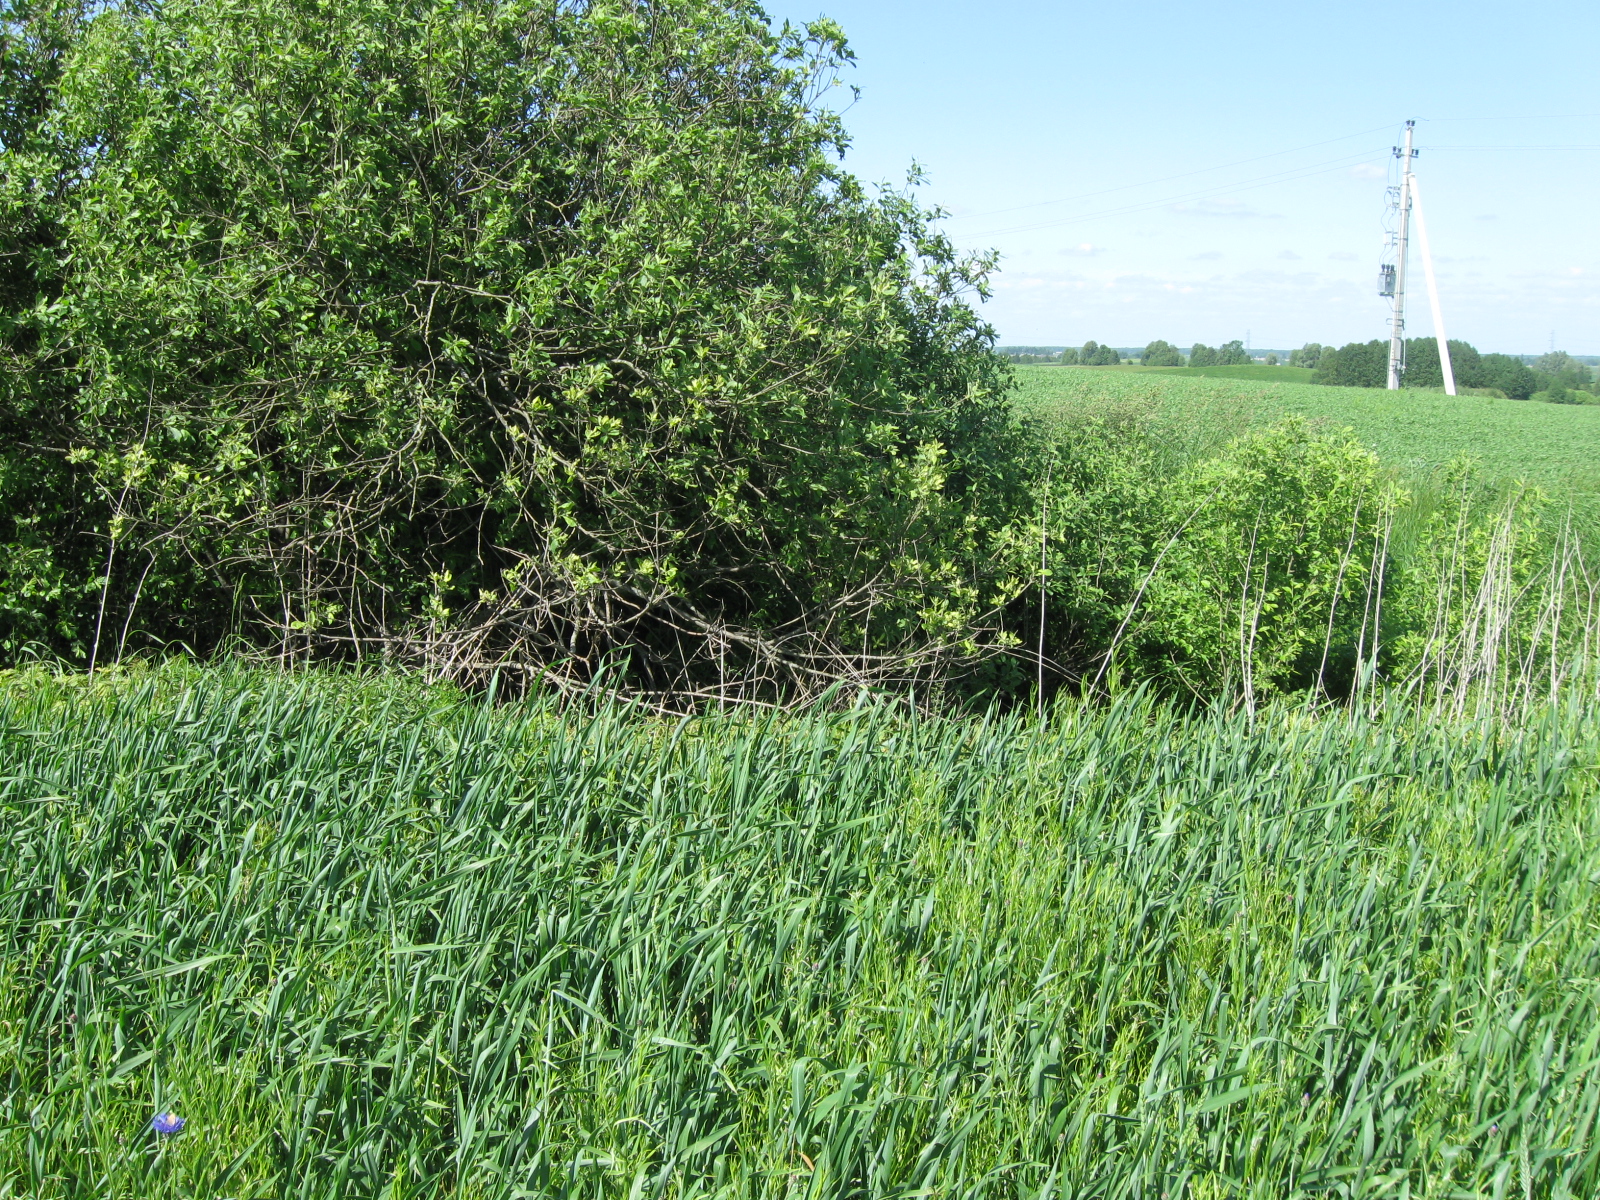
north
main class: Cropland
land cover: Common wheat
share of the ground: > 75 %
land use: Agriculture (excluding fallow land and kitchen gardens)
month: June
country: LT
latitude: 54.3981
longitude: 23.7811
